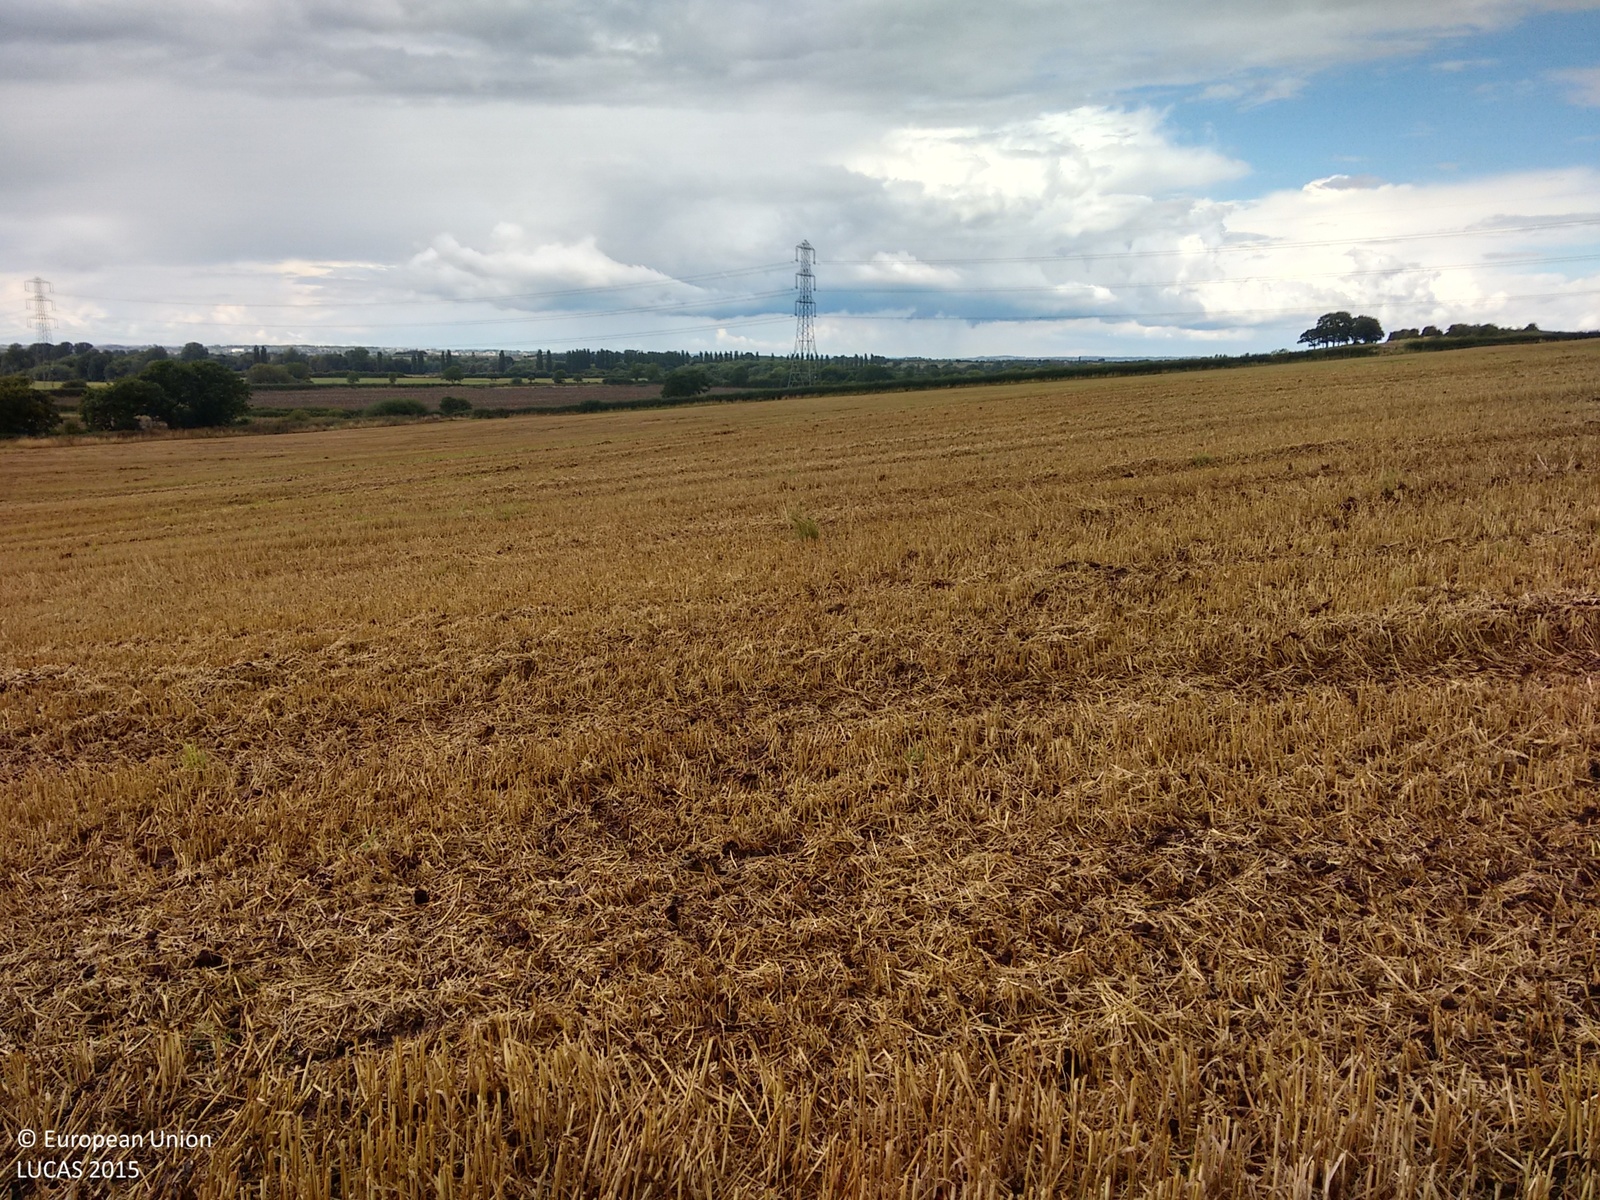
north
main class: Cropland
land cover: Common wheat
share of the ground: > 75 %
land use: Agriculture (excluding fallow land and kitchen gardens)
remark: Harvested field
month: September
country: GB
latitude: 52.8371
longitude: -1.4658
